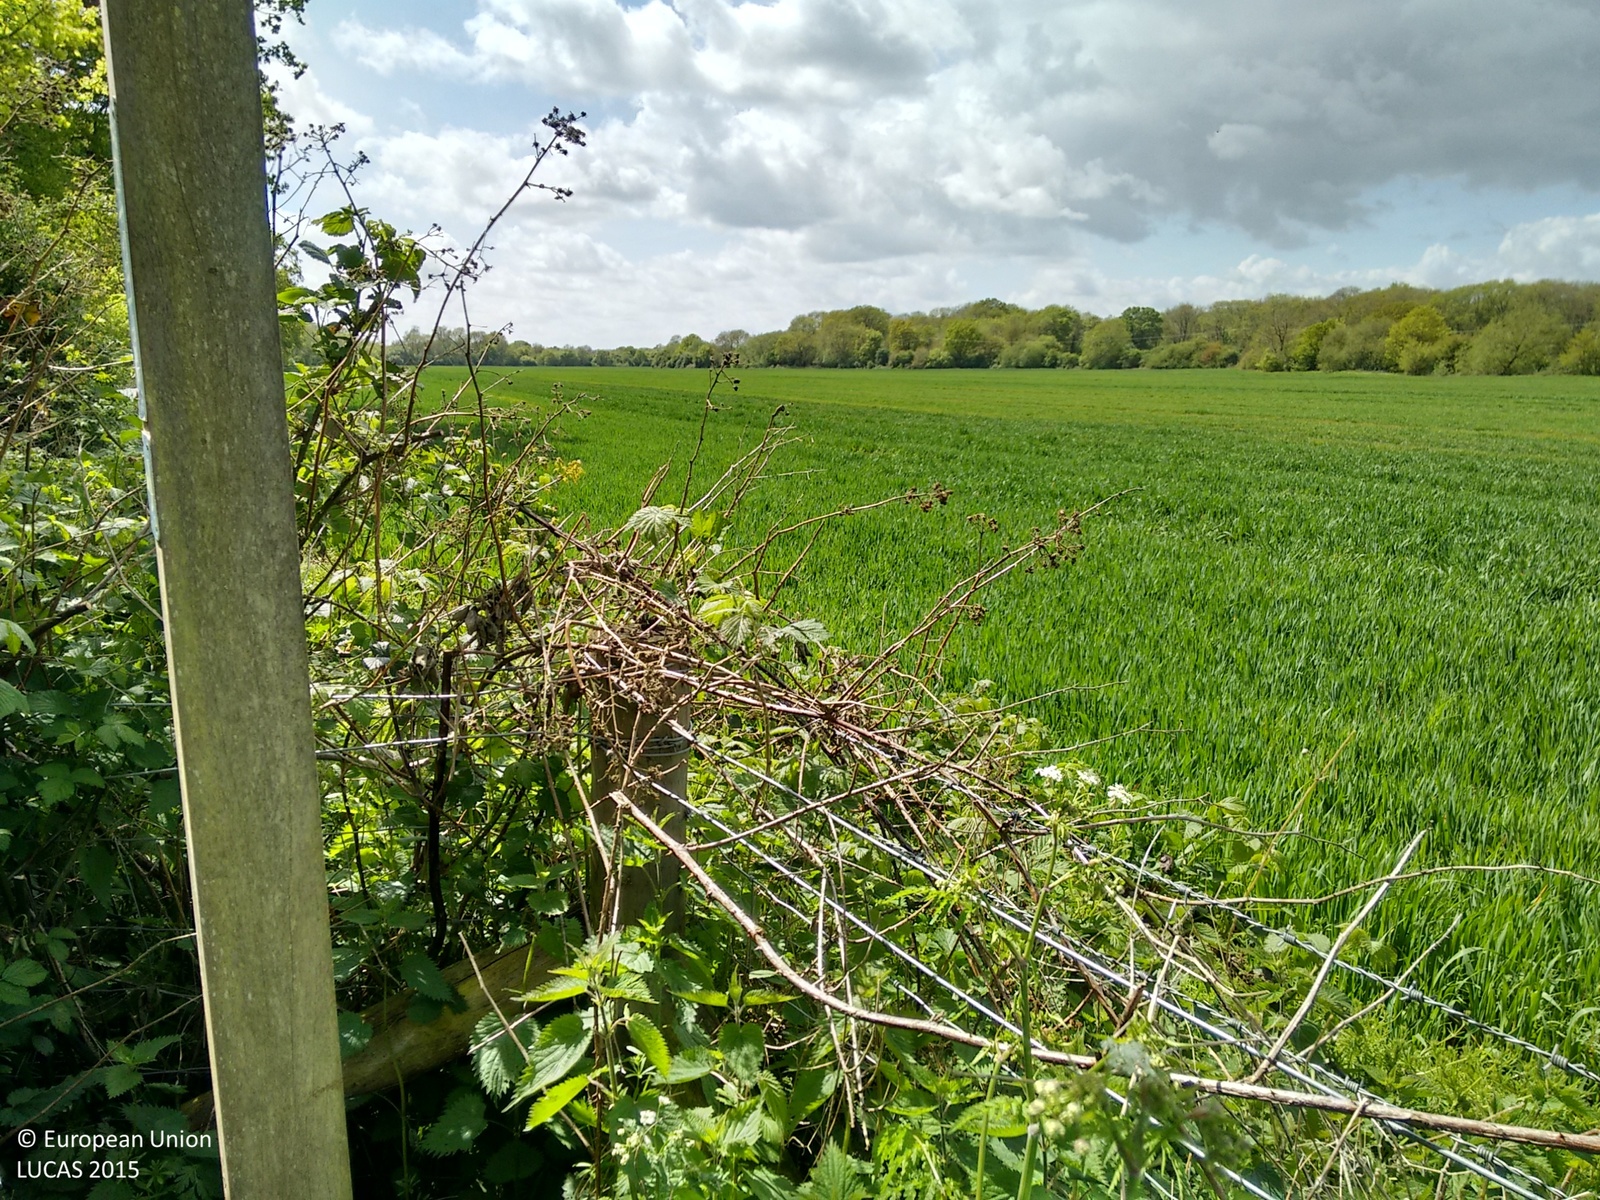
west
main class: Woodland
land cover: Broadleaved woodland
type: mesophytic deciduous forest
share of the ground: > 75 %
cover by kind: broadleaved forest trees 90 %, shrubs 10 %
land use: Semi-natural and natural areas not in use
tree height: > 5 m
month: May
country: GB
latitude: 51.1966
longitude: 0.2529
